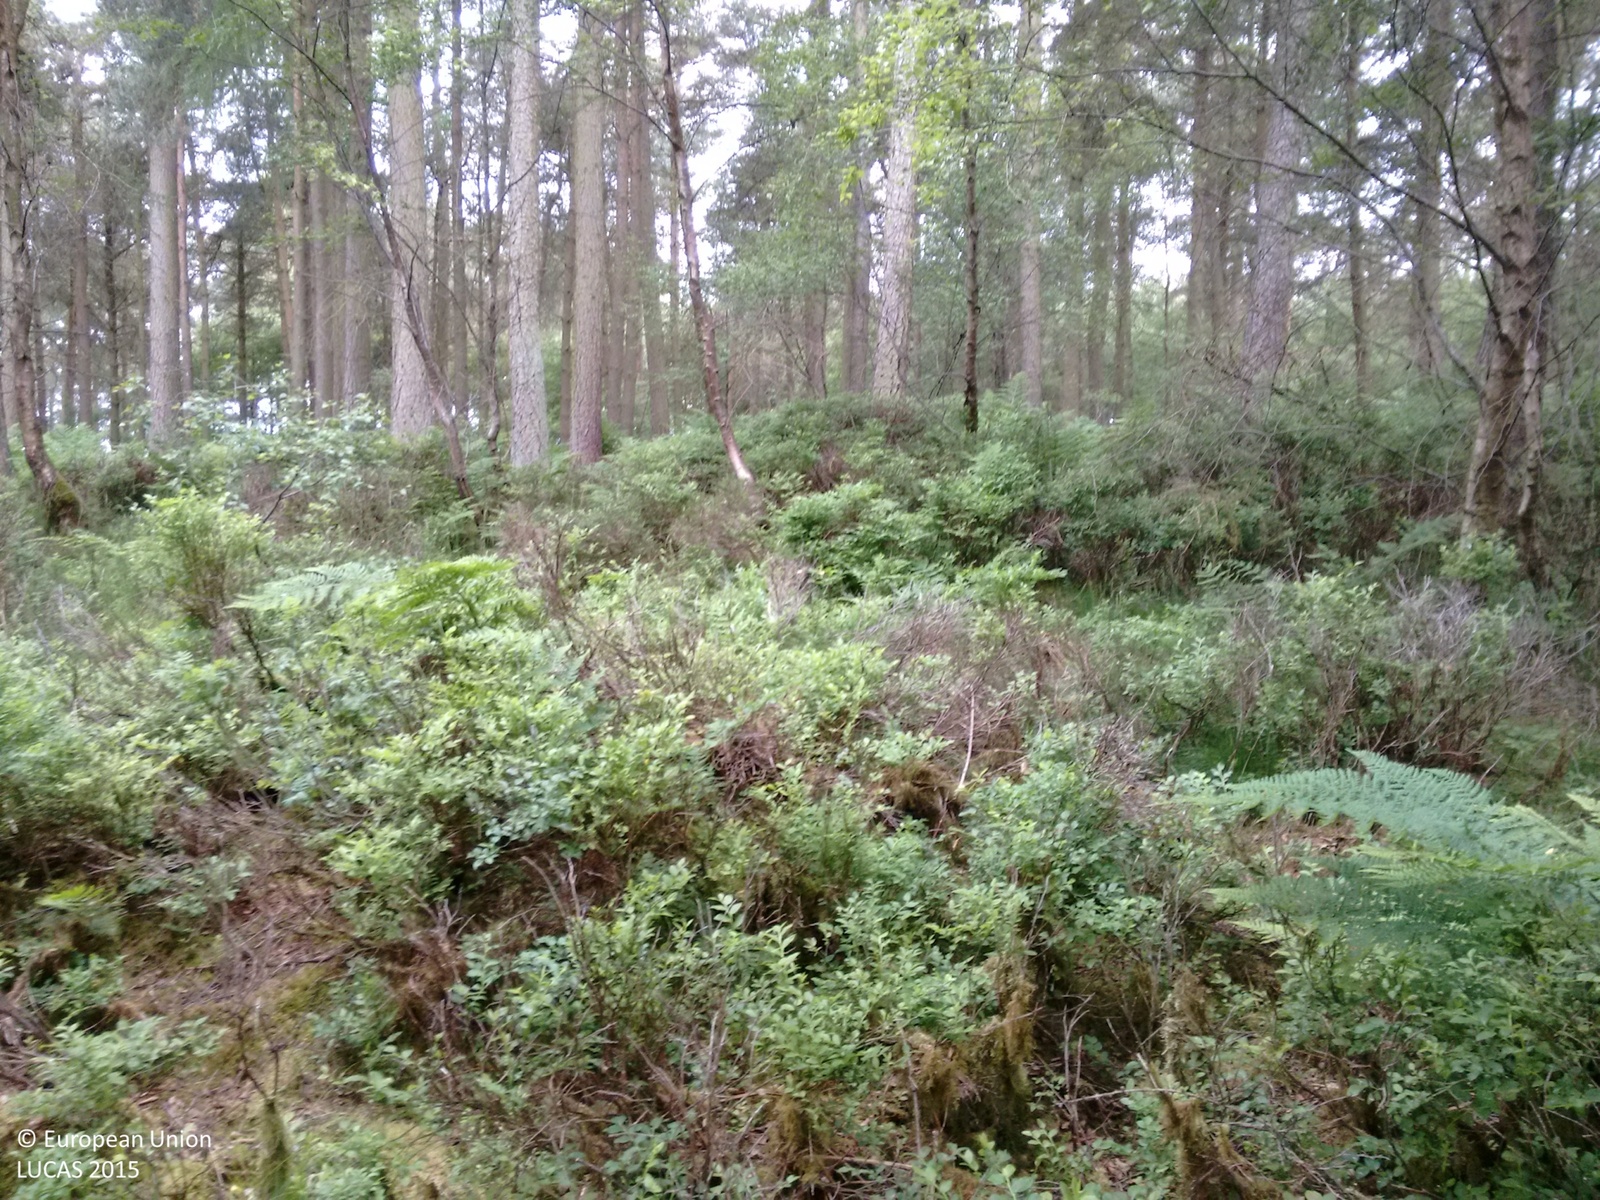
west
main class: Woodland
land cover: Pine dominated mixed woodland
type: exotic forest
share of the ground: > 75 %
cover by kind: coniferous forest trees 65 %, broadleaved forest trees 35 %
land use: Forestry
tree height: > 5 m
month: June
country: GB
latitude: 54.2862
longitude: -1.1192
